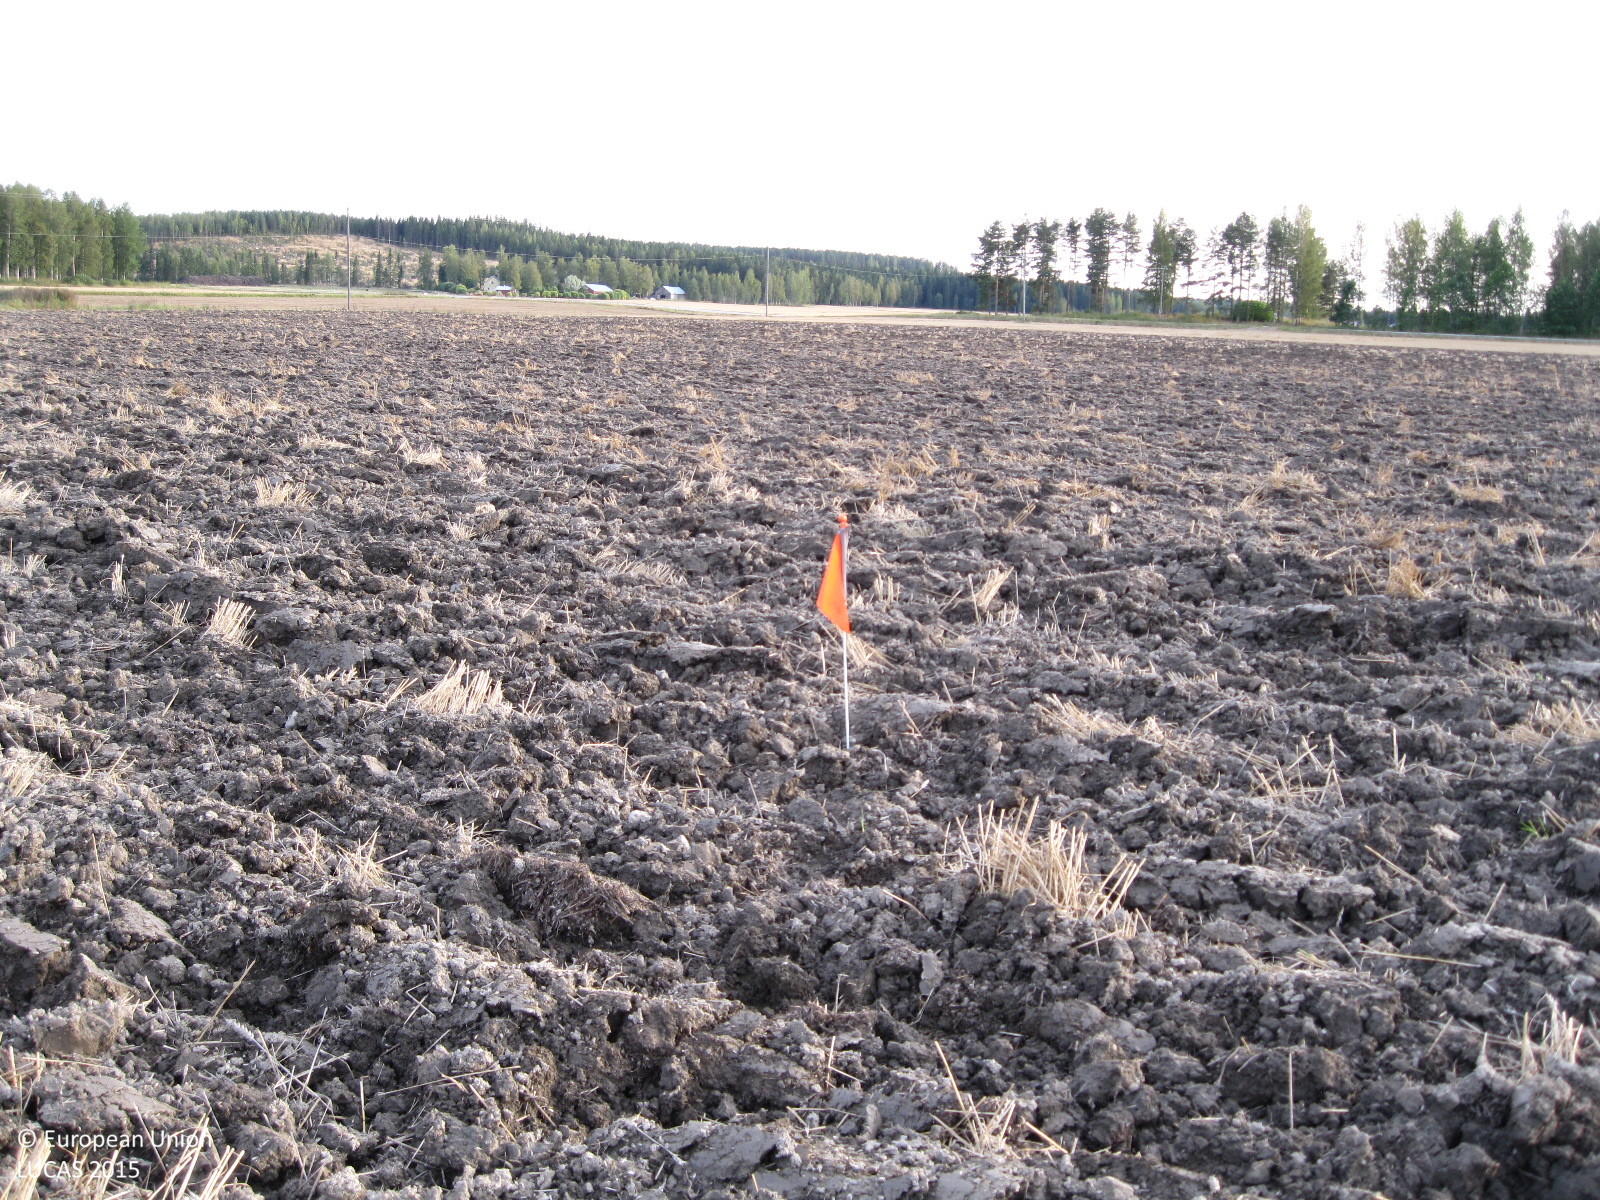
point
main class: Cropland
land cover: Common wheat
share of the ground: > 75 %
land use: Agriculture (excluding fallow land and kitchen gardens)
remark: Harvested field
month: September
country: FI
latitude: 60.5768
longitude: 24.7279
